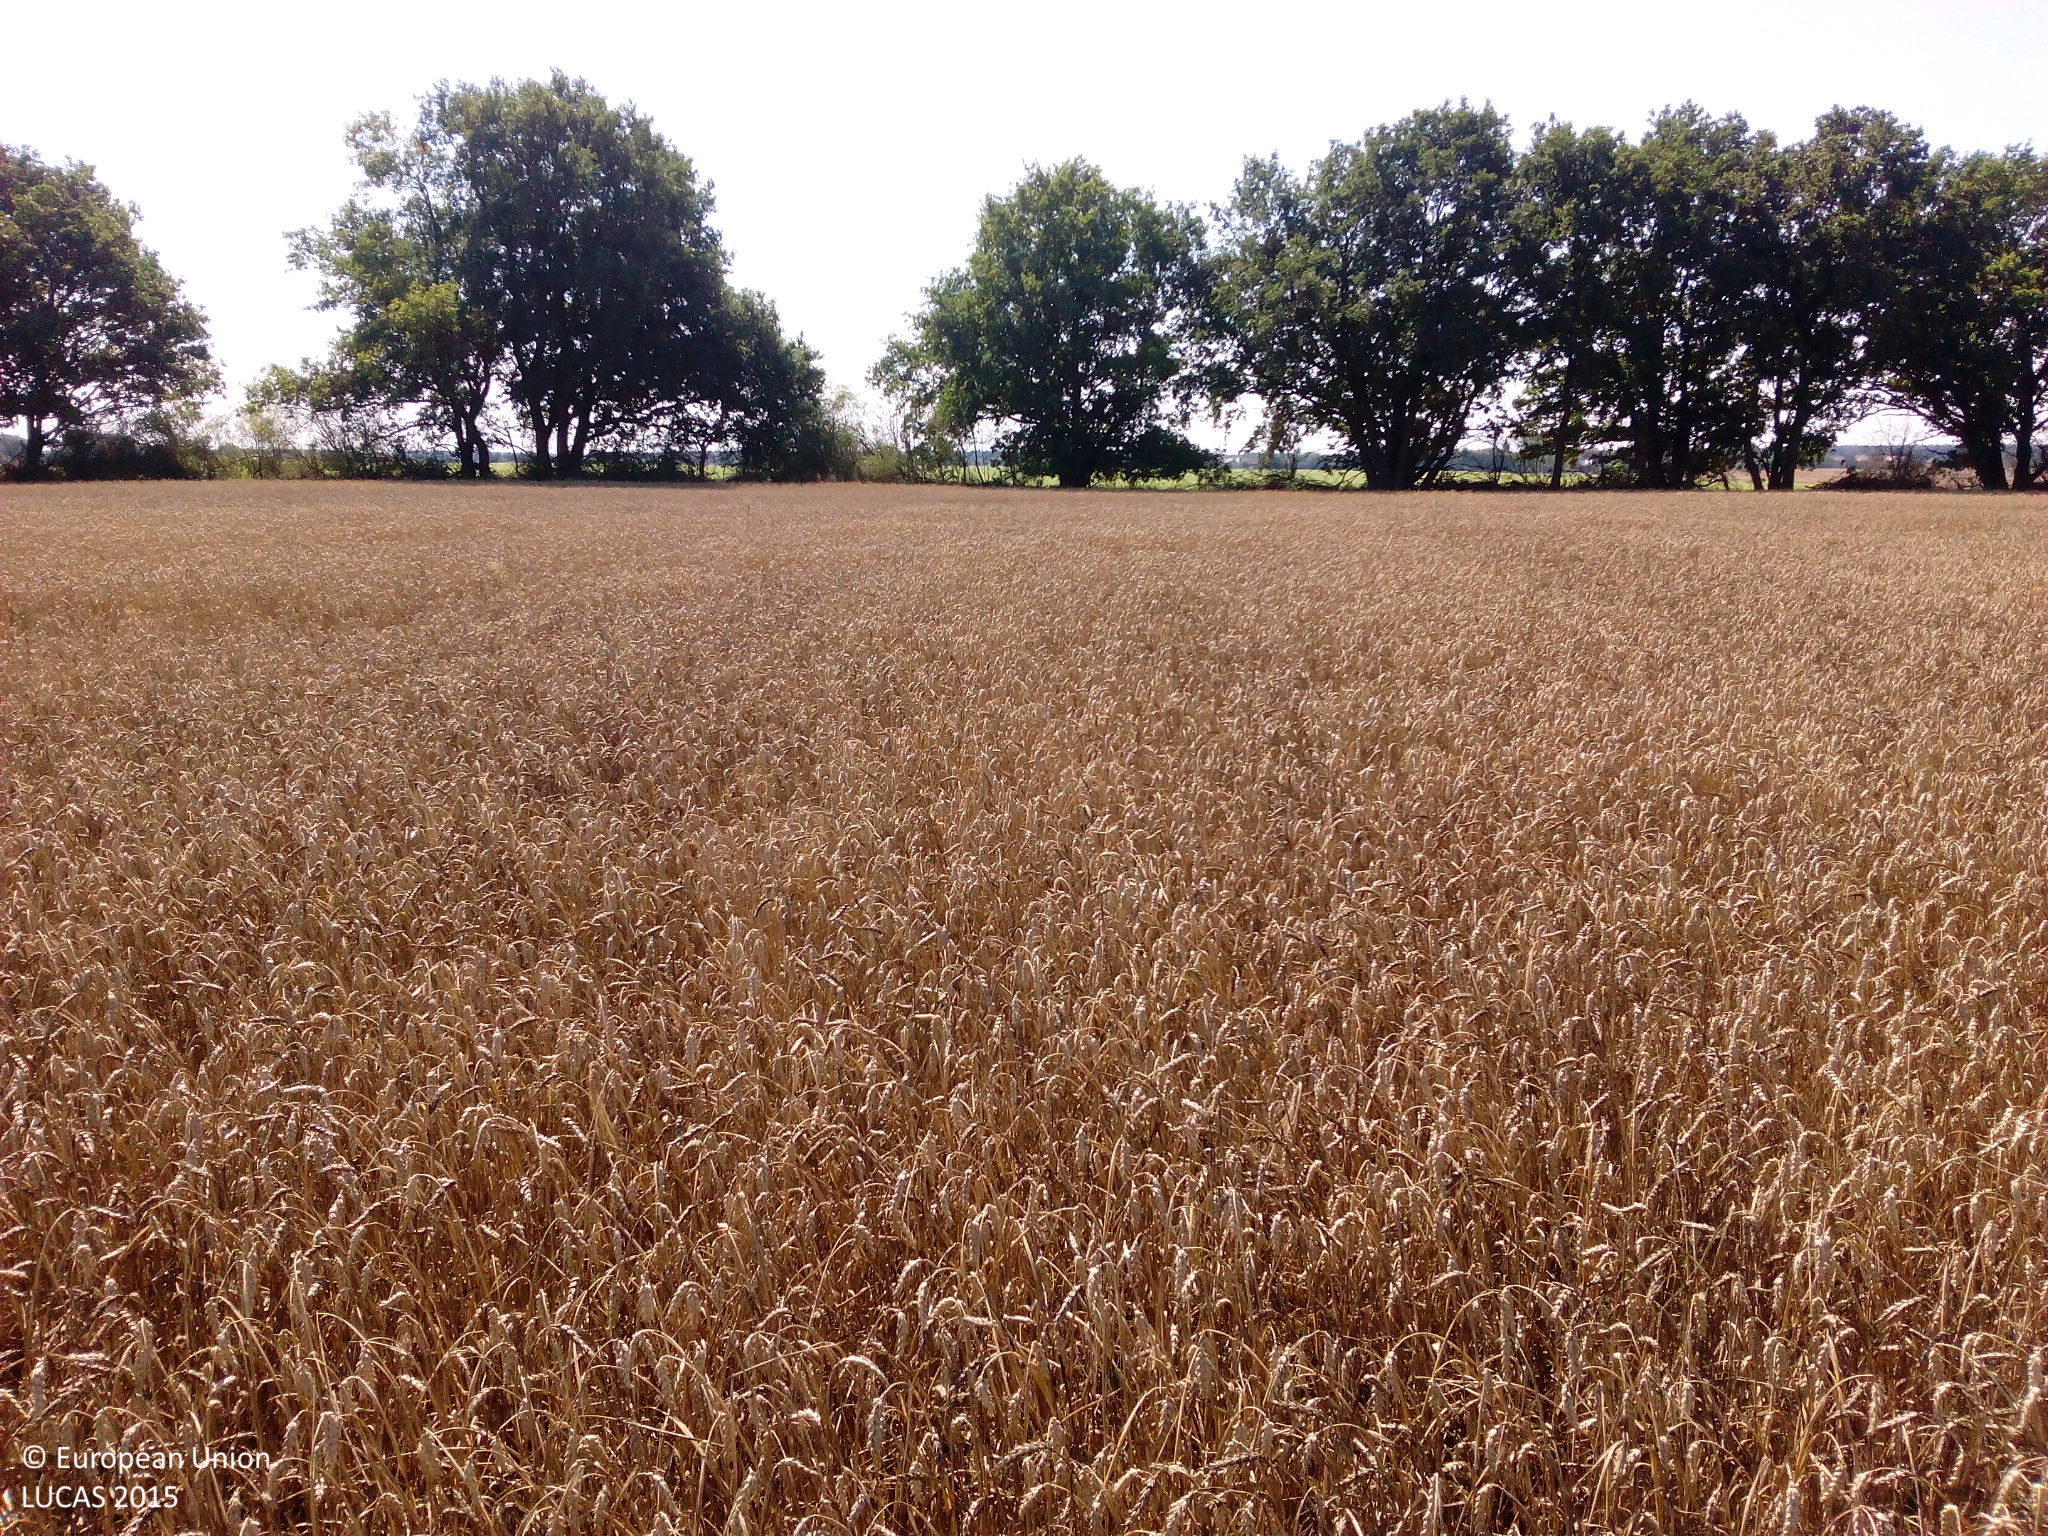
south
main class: Cropland
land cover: Common wheat
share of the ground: > 75 %
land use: Agriculture (excluding fallow land and kitchen gardens)
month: August
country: DE
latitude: 51.9428
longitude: 13.0403
